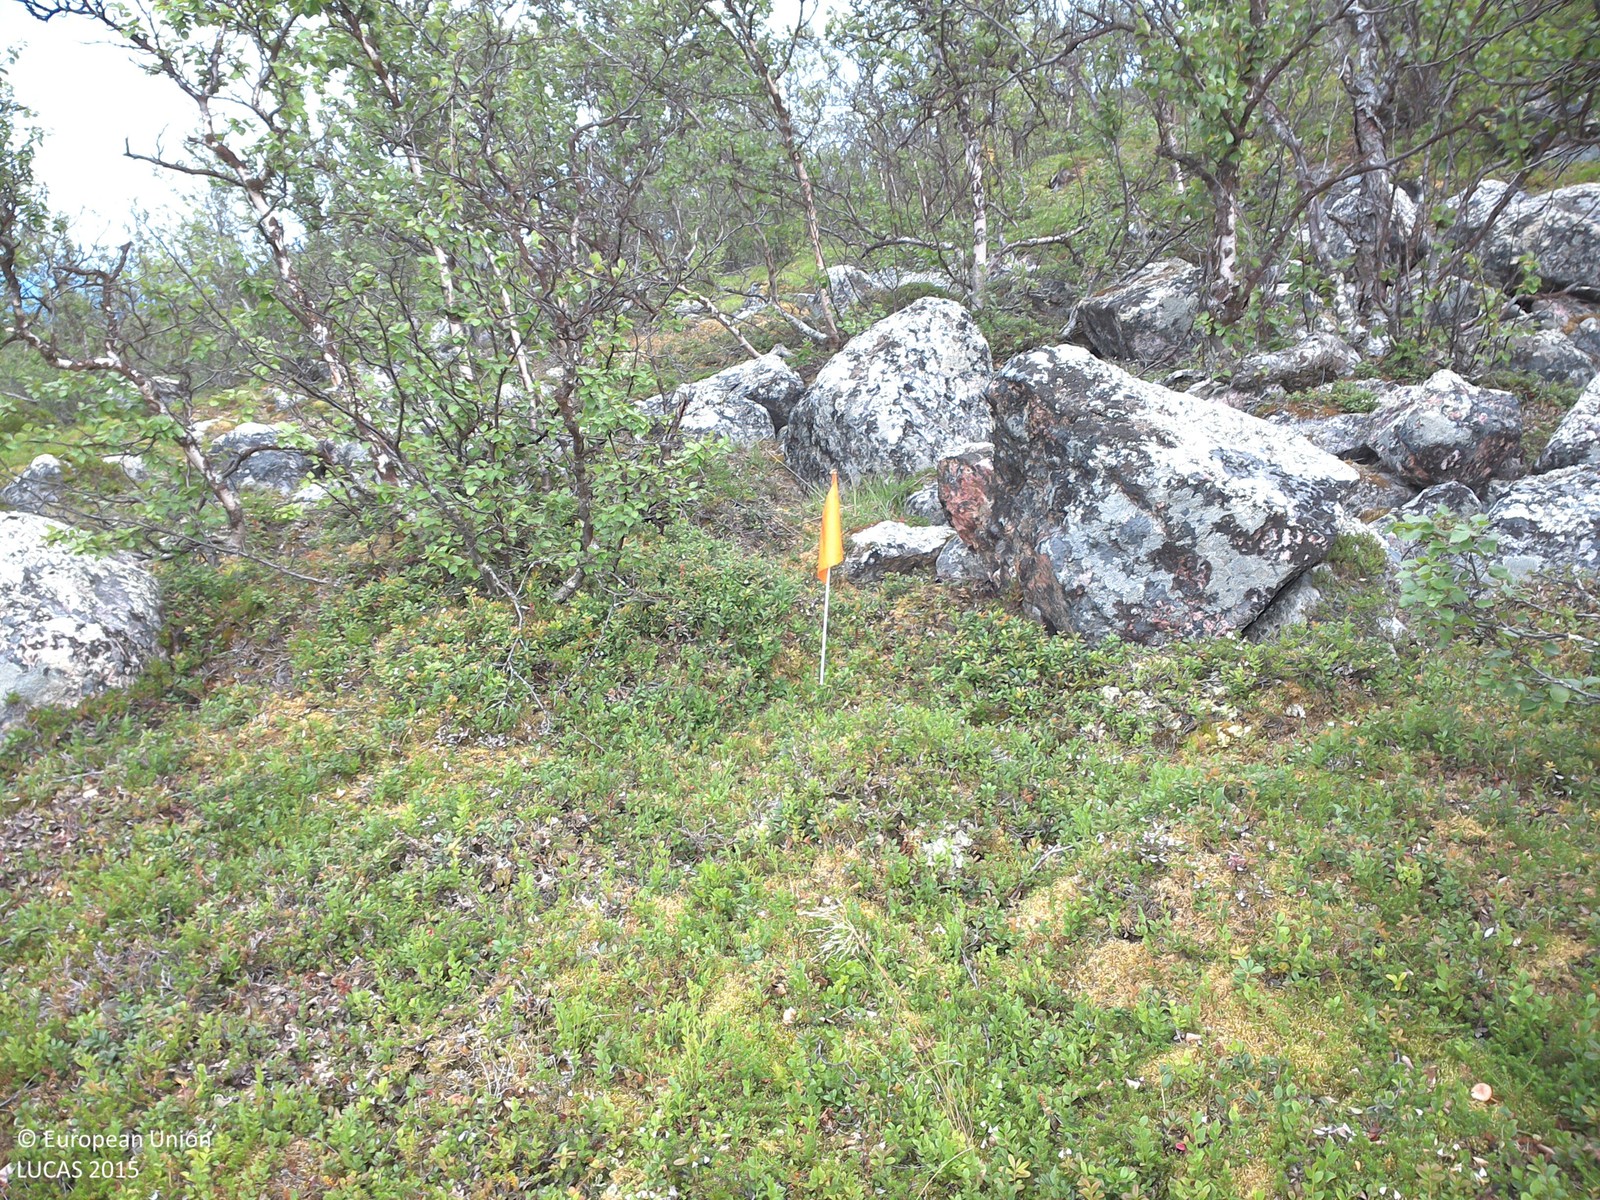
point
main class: Woodland
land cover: Broadleaved woodland
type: boreal forest
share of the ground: 10 - 25 %
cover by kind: shrubs 60 %, broadleaved forest trees 20 %, lichens and mosses 20 %
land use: Forestry
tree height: < 5 m
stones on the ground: > 50 %
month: August
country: SE
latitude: 68.2360
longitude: 19.5276
